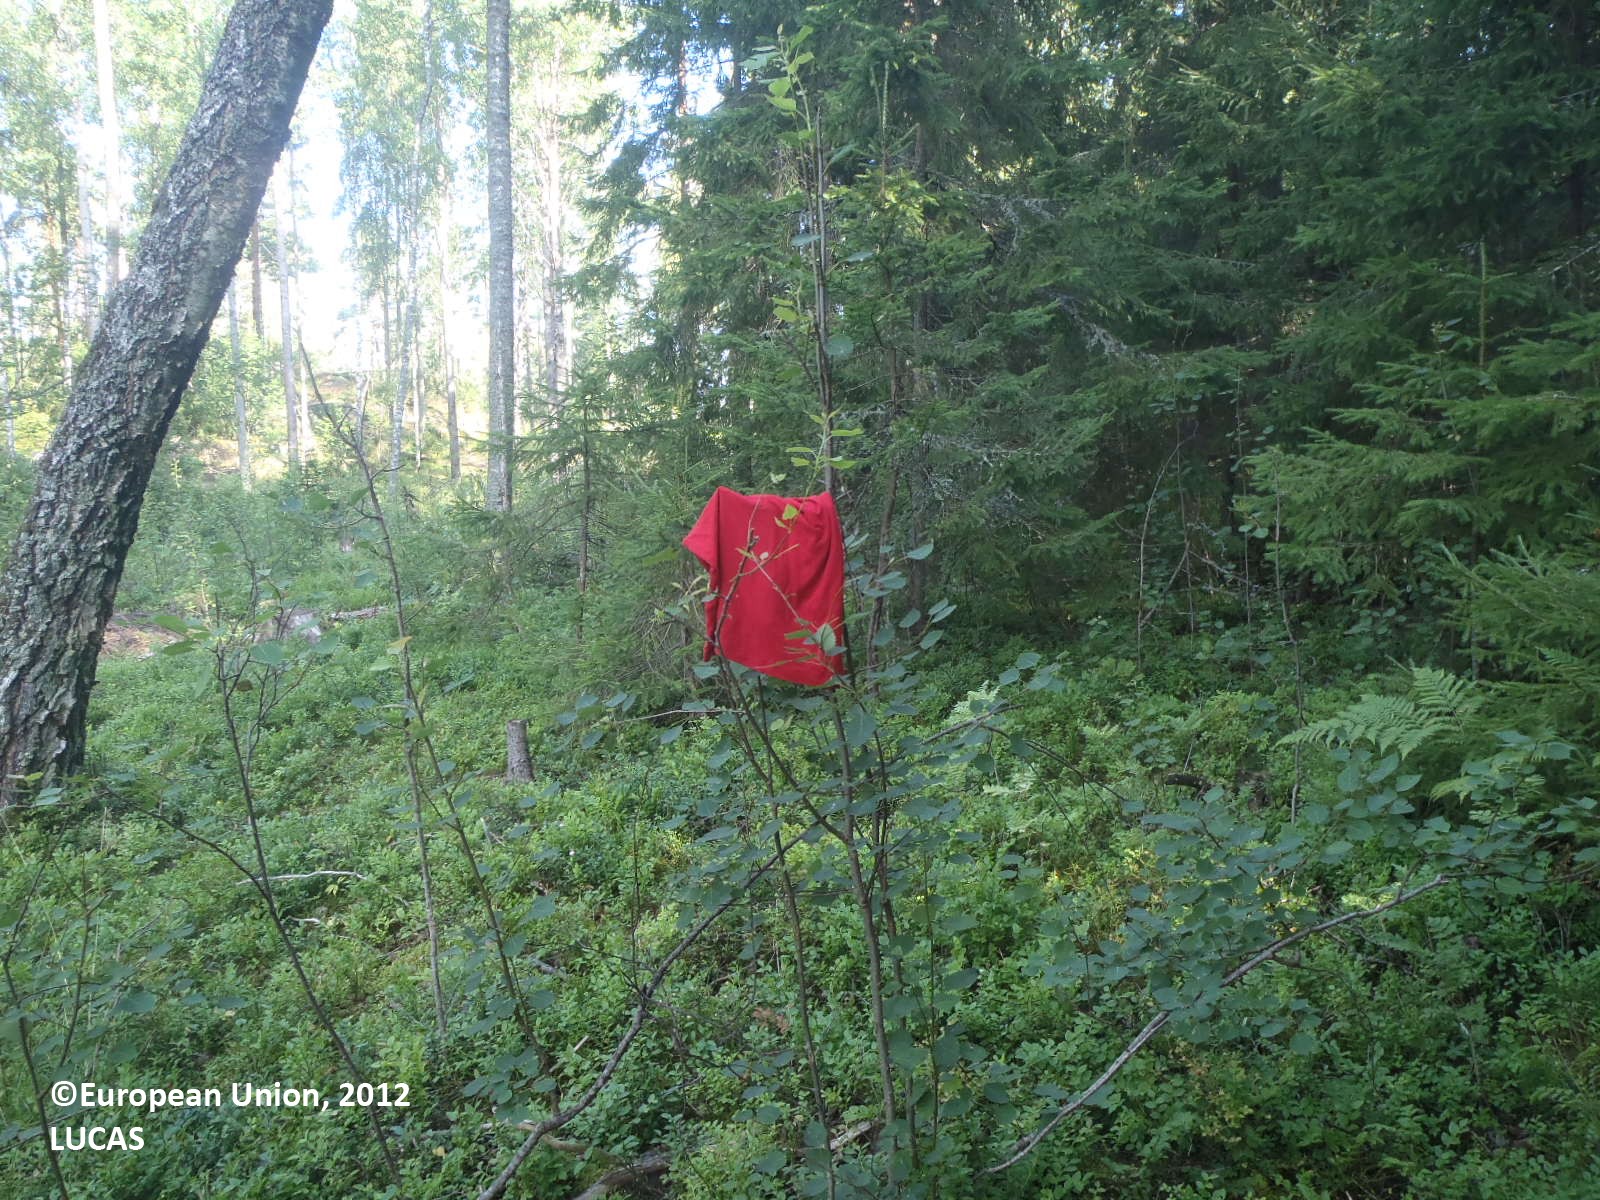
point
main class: Woodland
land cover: Spruce dominated mixed woodland
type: boreal forest
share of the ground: > 75 %
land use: Forestry
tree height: > 5 m
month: July
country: FI
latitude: 60.3724
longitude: 22.2721
